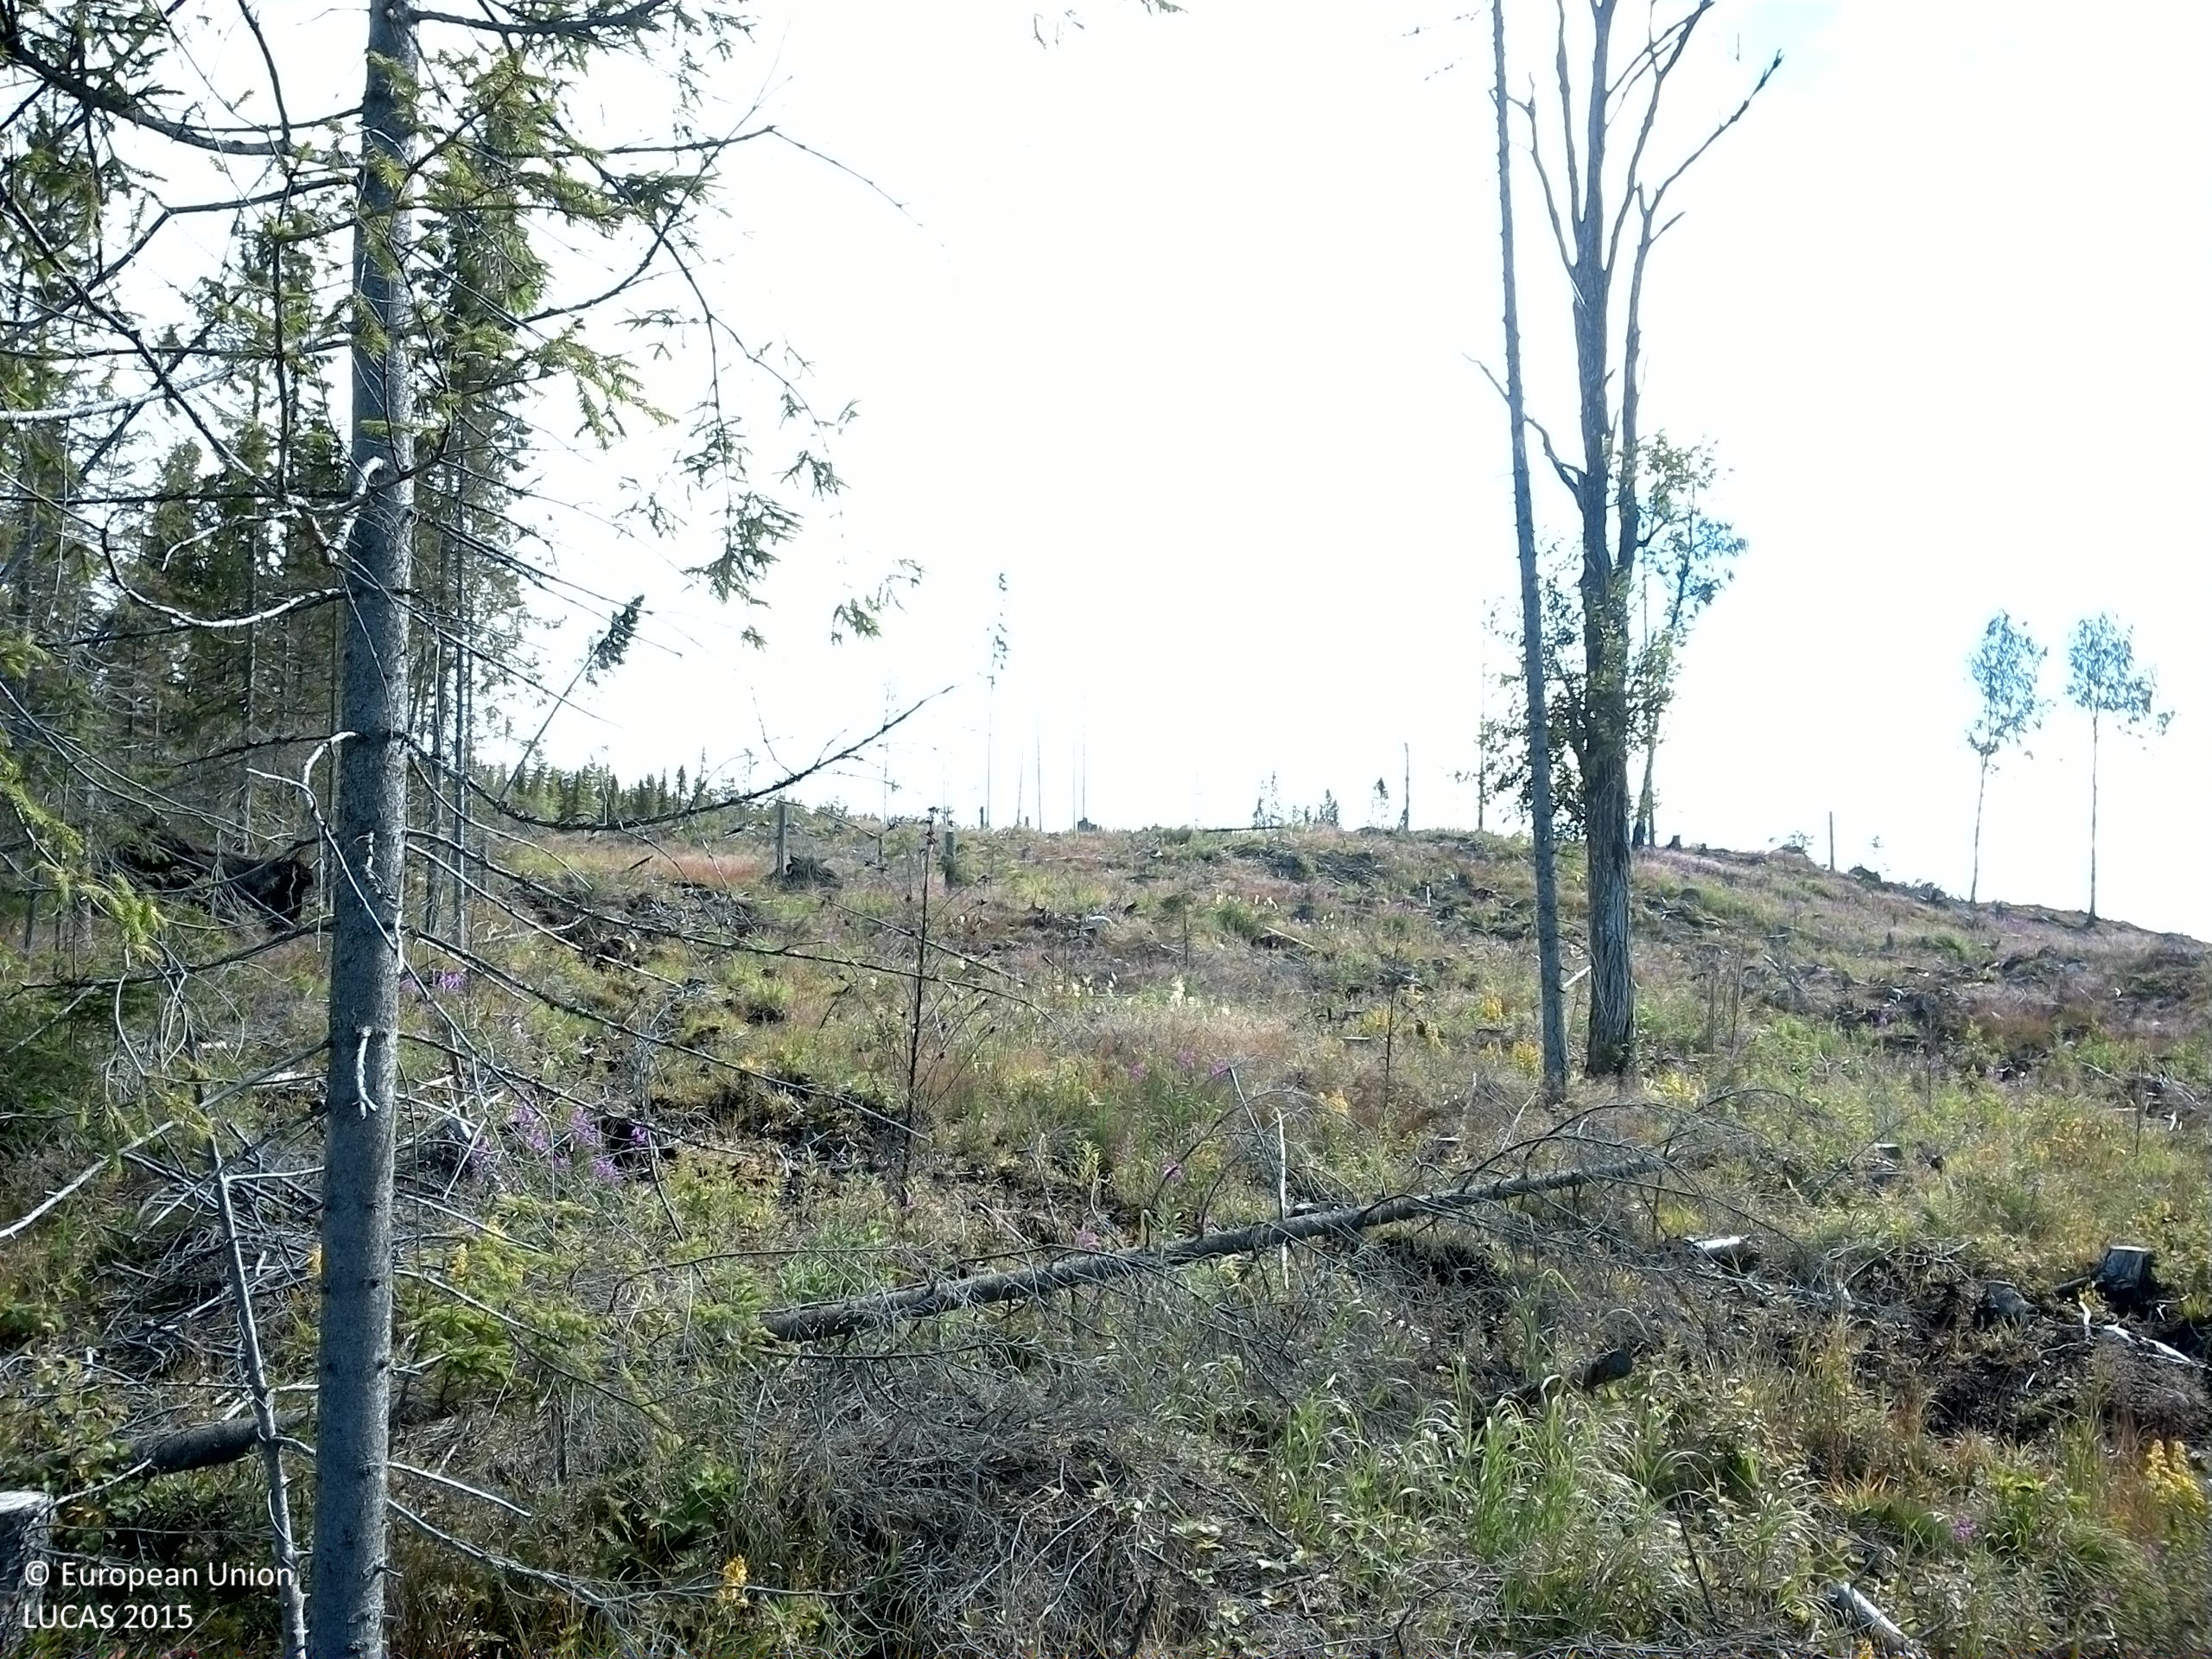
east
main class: Woodland
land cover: Spruce dominated mixed woodland
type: boreal forest
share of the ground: 10 - 25 %
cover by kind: shrubs 45 %, herbaceous plants 25 %, coniferous forest trees 10 %, lichens and mosses 10 %, broadleaved forest trees 5 %, consolidated bare surface 5 %
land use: Forestry
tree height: < 5 m
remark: Clear cut
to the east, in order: Spruce dominated mixed woodland; Grassland with sparse tree/shrub cover; Spruce dominated mixed woodland
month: August
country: SE
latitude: 62.8496
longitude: 16.5577
